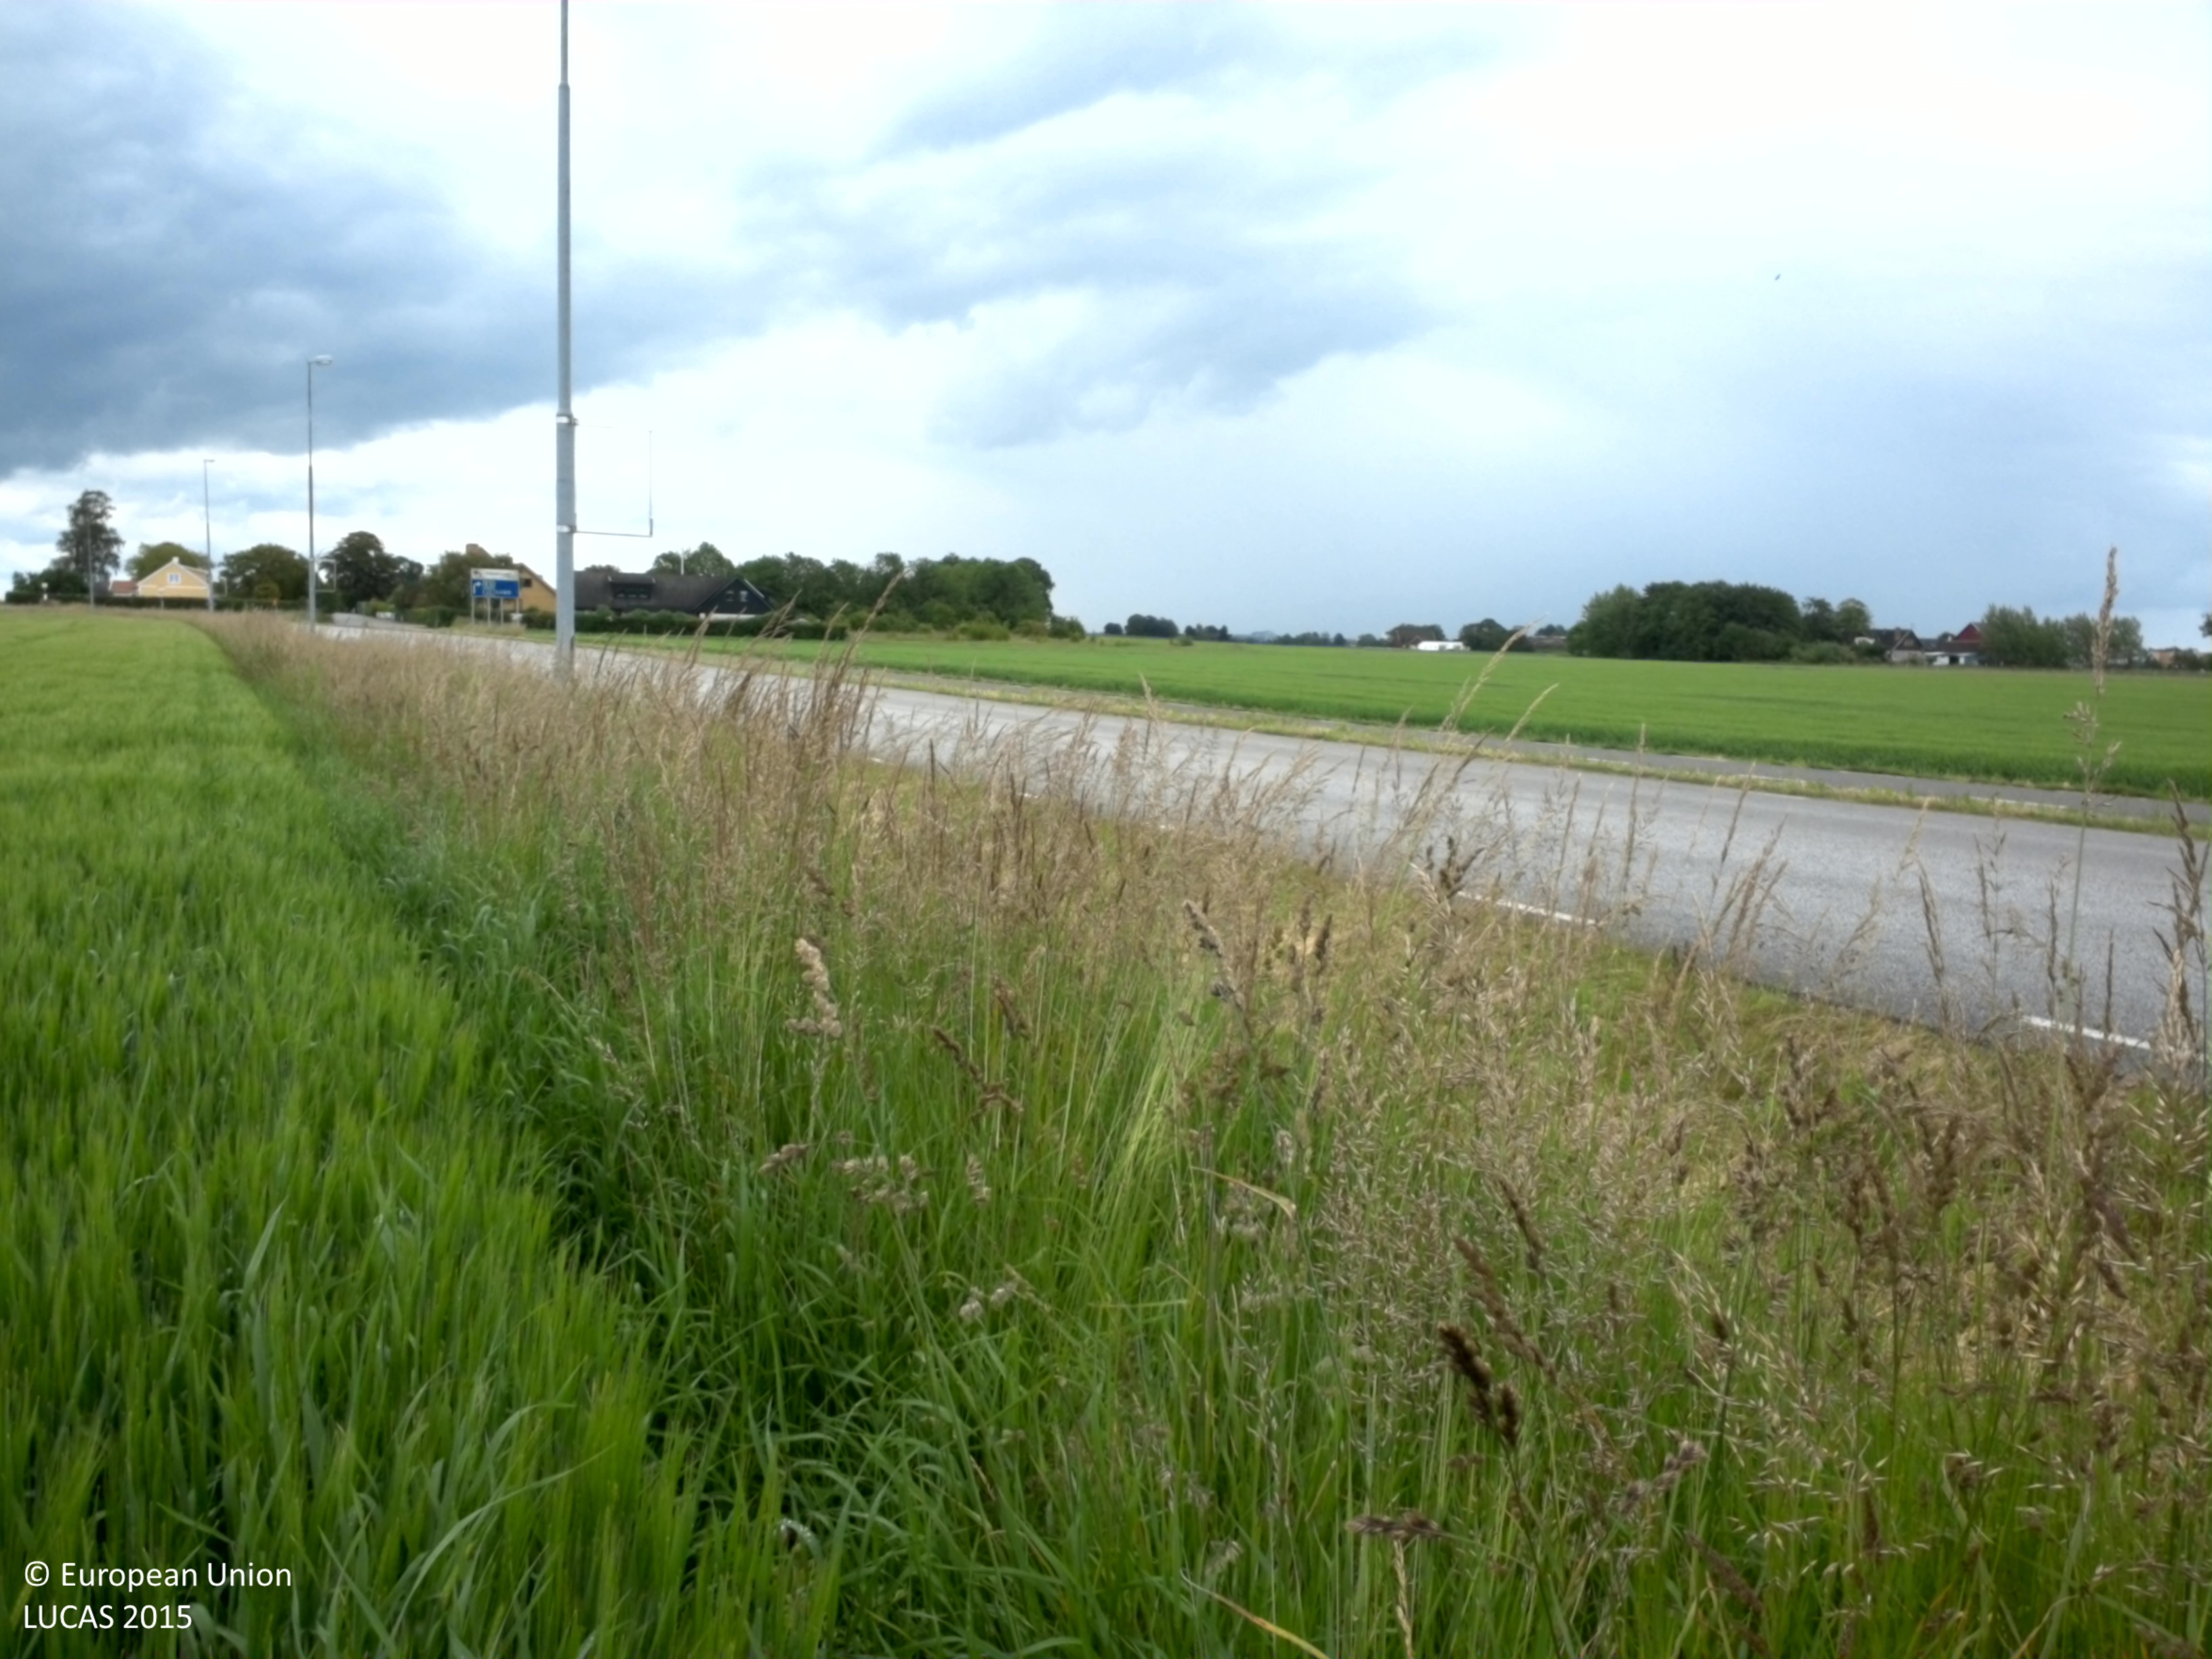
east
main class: Cropland
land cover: Barley
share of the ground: > 75 %
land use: Agriculture (excluding fallow land and kitchen gardens)
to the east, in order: Barley; Grass margins; Paved roads, cycling and walking lanes; Grass margins; Paved roads, cycling and walking lanes; Grass margins; Barley; Grassland without tree/shrub cover
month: June
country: SE
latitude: 55.7201
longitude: 13.0386
